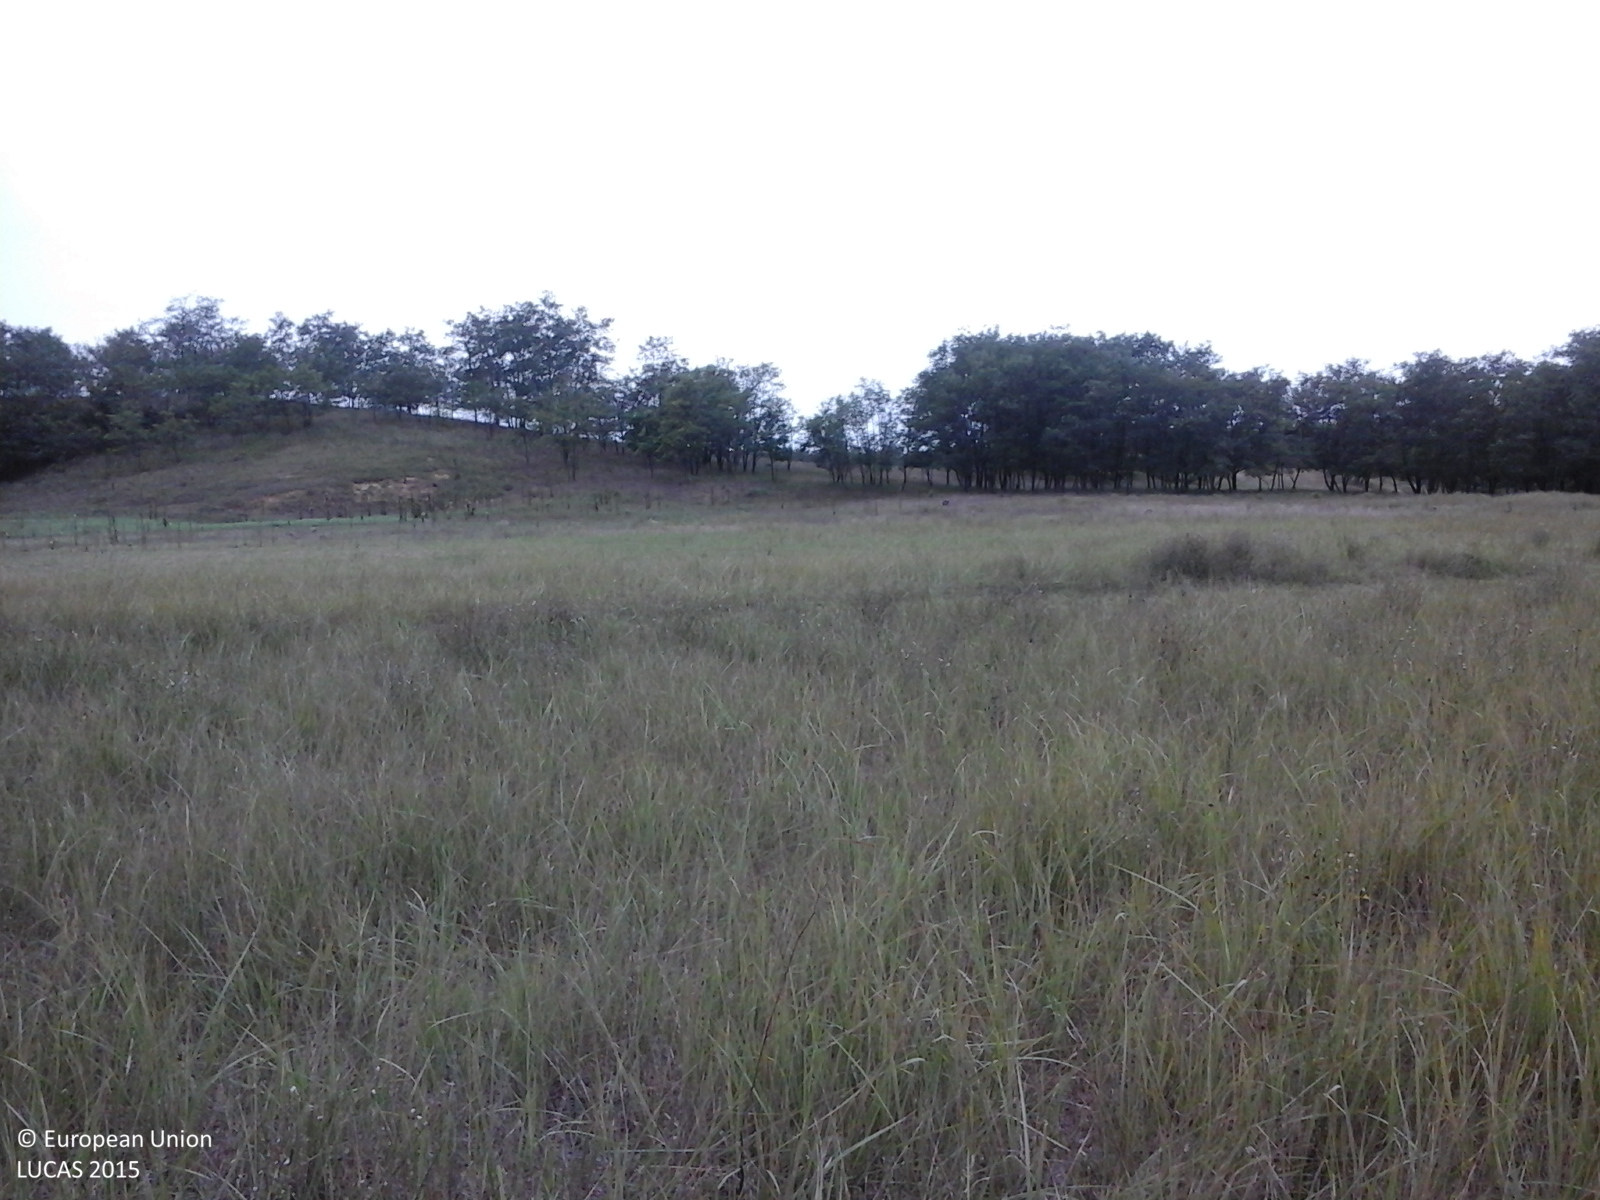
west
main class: Grassland
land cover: Spontaneously vegetated surfaces
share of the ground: > 75 %
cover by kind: herbaceous plants 100 %
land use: Fallow land
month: September
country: RO
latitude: 47.5389
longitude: 22.0738
